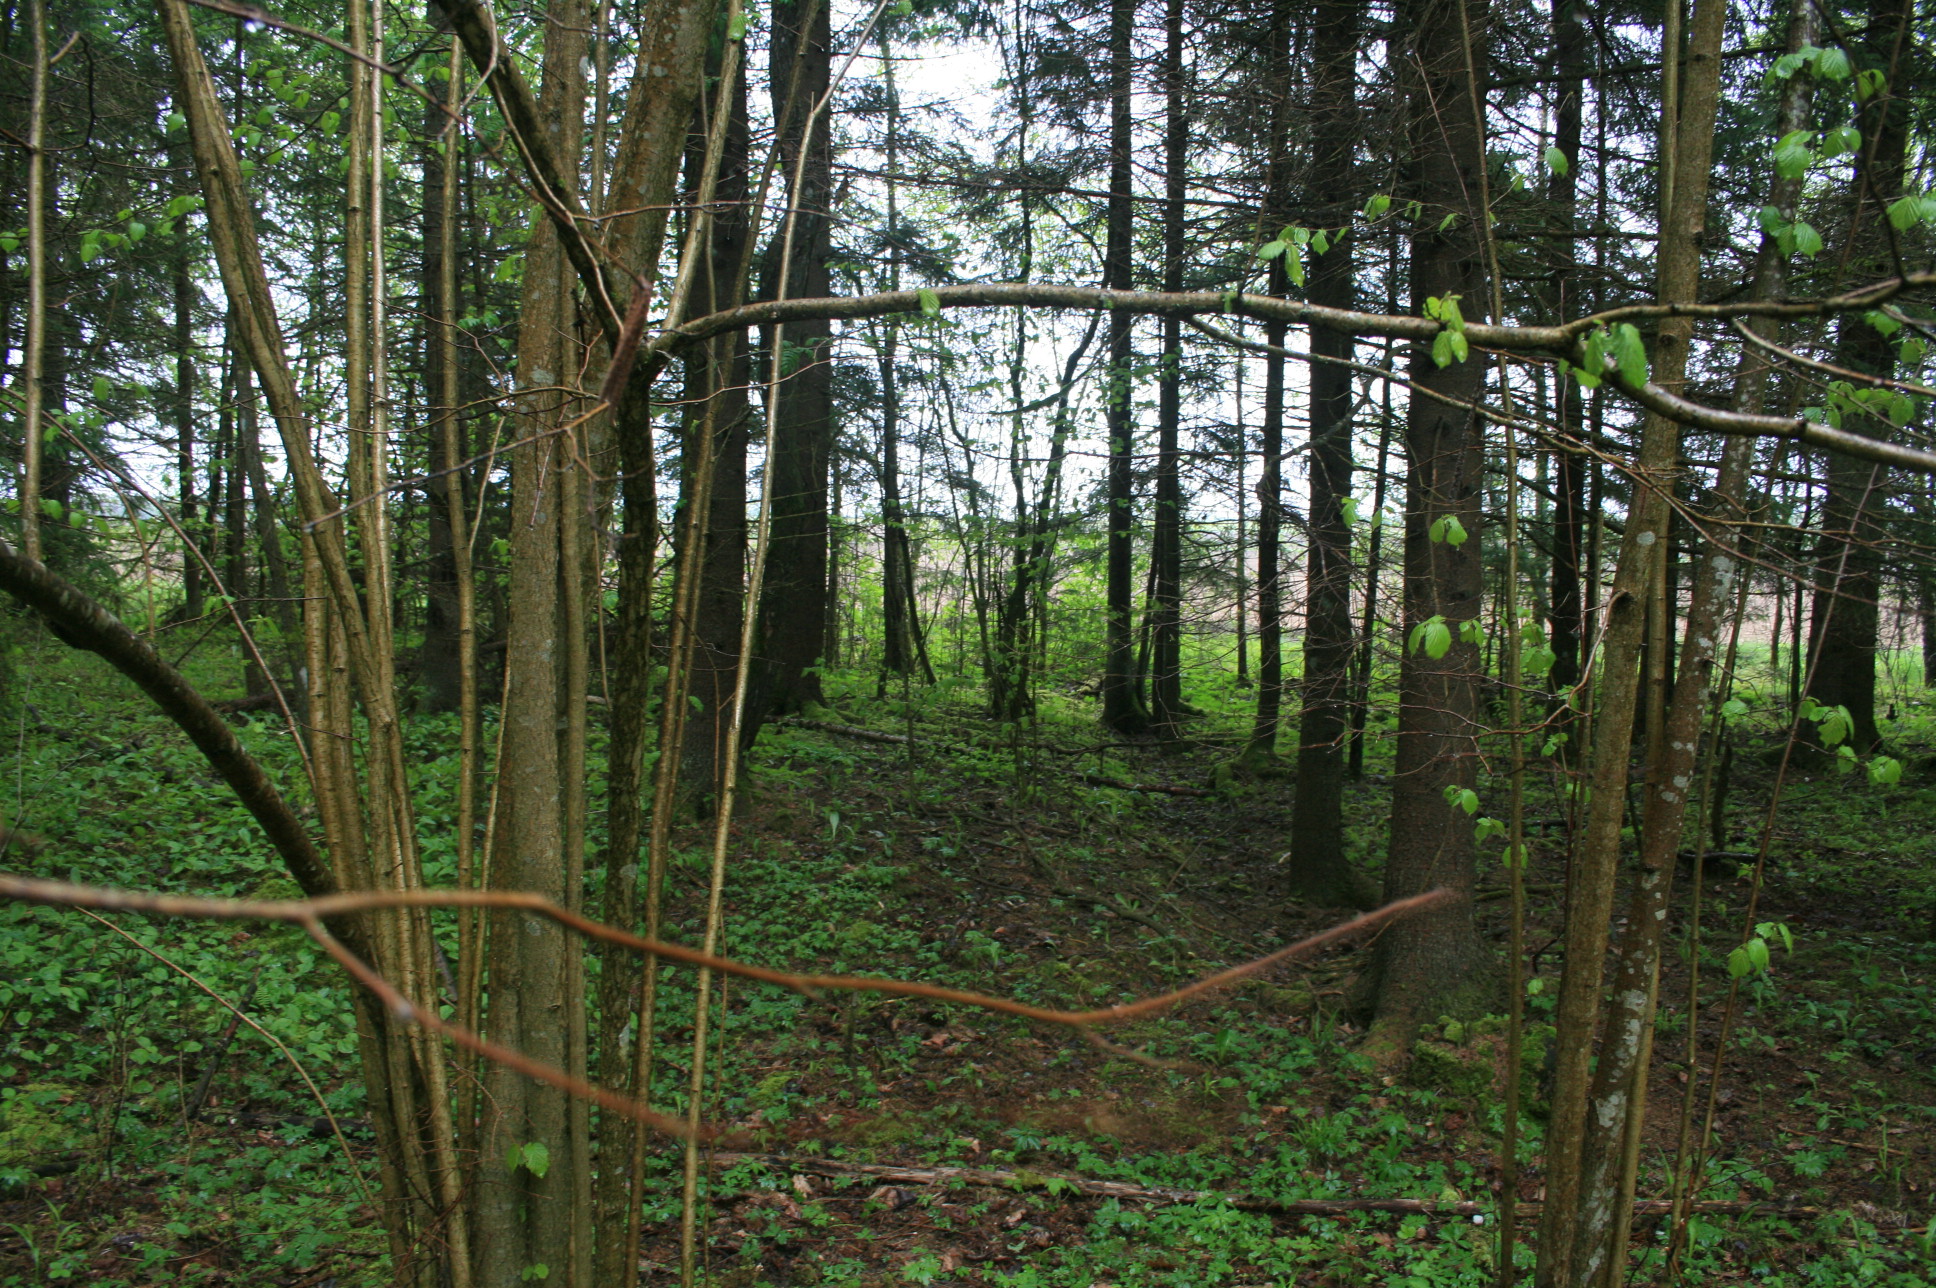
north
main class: Woodland
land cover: Spruce dominated mixed woodland
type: hemiboreal forest and nemoral coniferous forest and mixed broadleaved-coniferous forest
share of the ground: > 75 %
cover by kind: coniferous forest trees 70 %, broadleaved forest trees 25 %, lichens and mosses 5 %
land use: Forestry
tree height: > 5 m
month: May
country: LT
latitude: 56.2080
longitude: 21.9638
